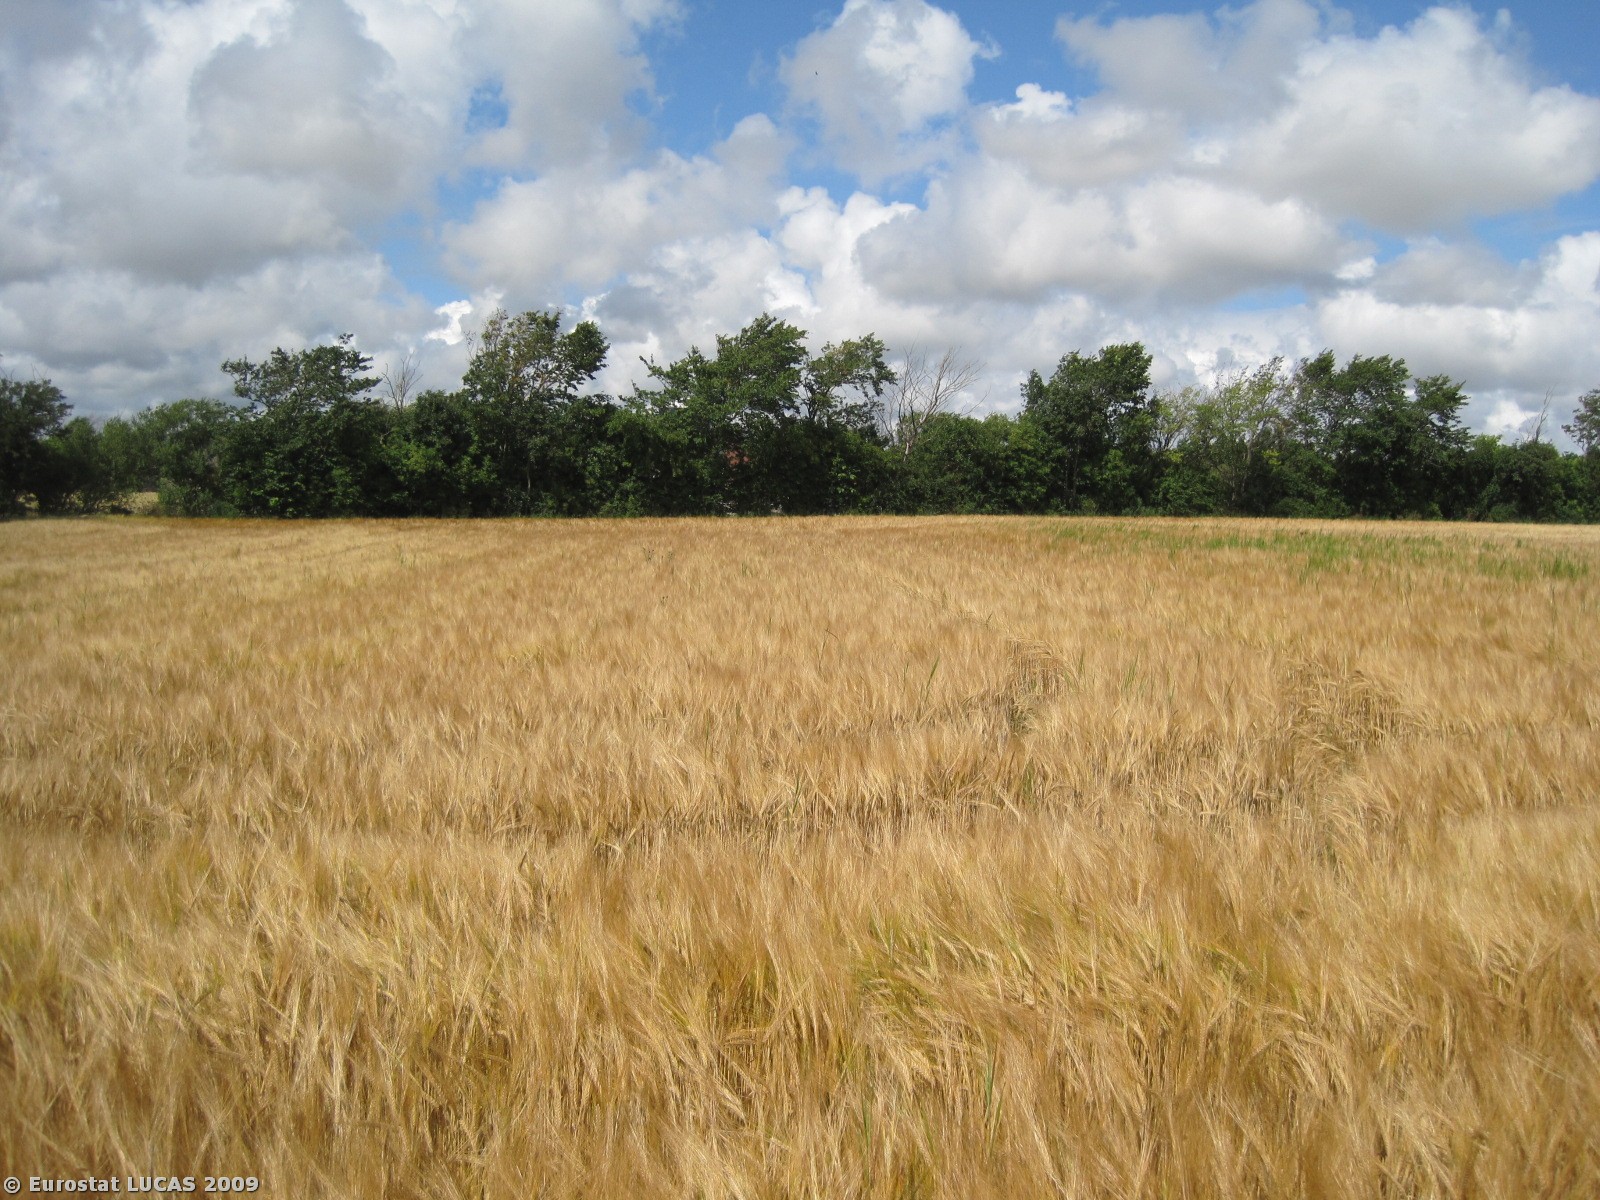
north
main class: Cropland
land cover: Barley
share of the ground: > 75 %
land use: Agriculture (excluding fallow land and kitchen gardens)
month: July
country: DK
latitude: 56.9726
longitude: 8.7351
